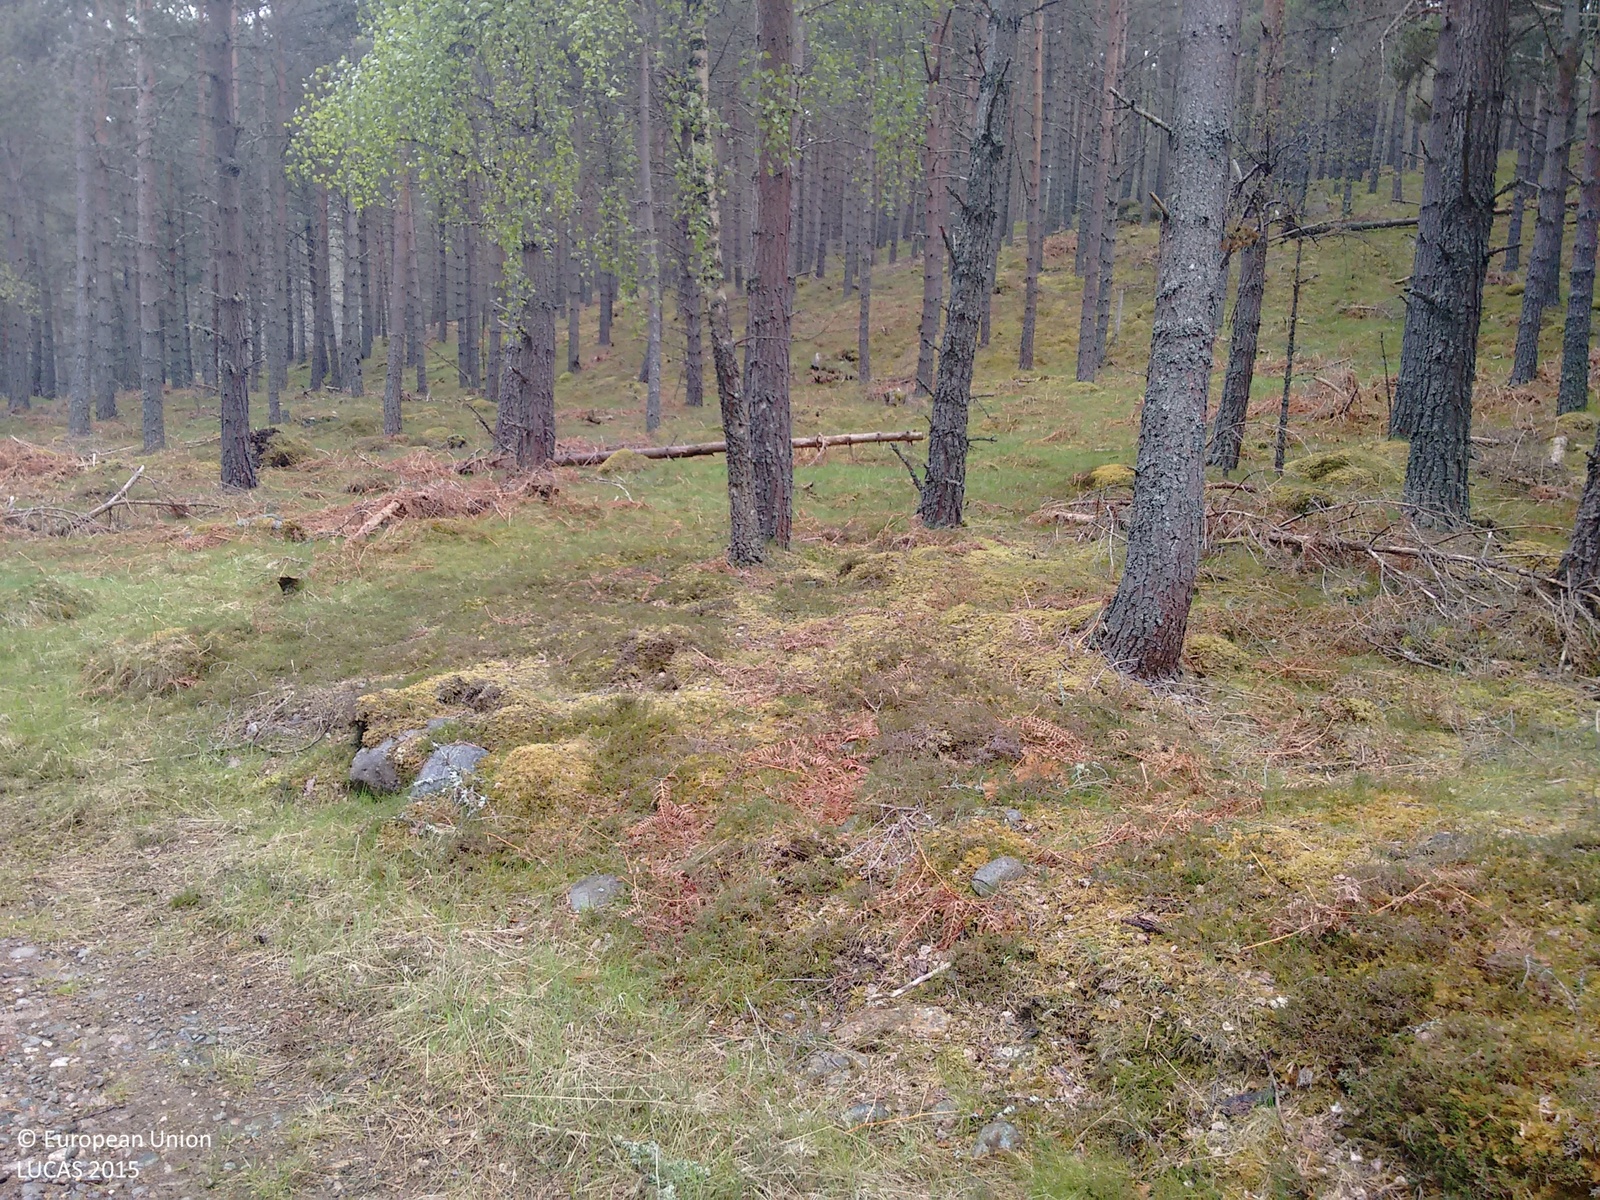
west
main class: Woodland
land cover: Pine dominated coniferous woodland
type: exotic forest
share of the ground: > 75 %
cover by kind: coniferous forest trees 70 %, lichens and mosses 10 %, consolidated bare surface 10 %, broadleaved forest trees 5 %, shrubs 5 %
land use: Forestry
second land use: Amenities, museums, leisure
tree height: > 5 m
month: June
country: GB
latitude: 57.2451
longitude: -3.8159
